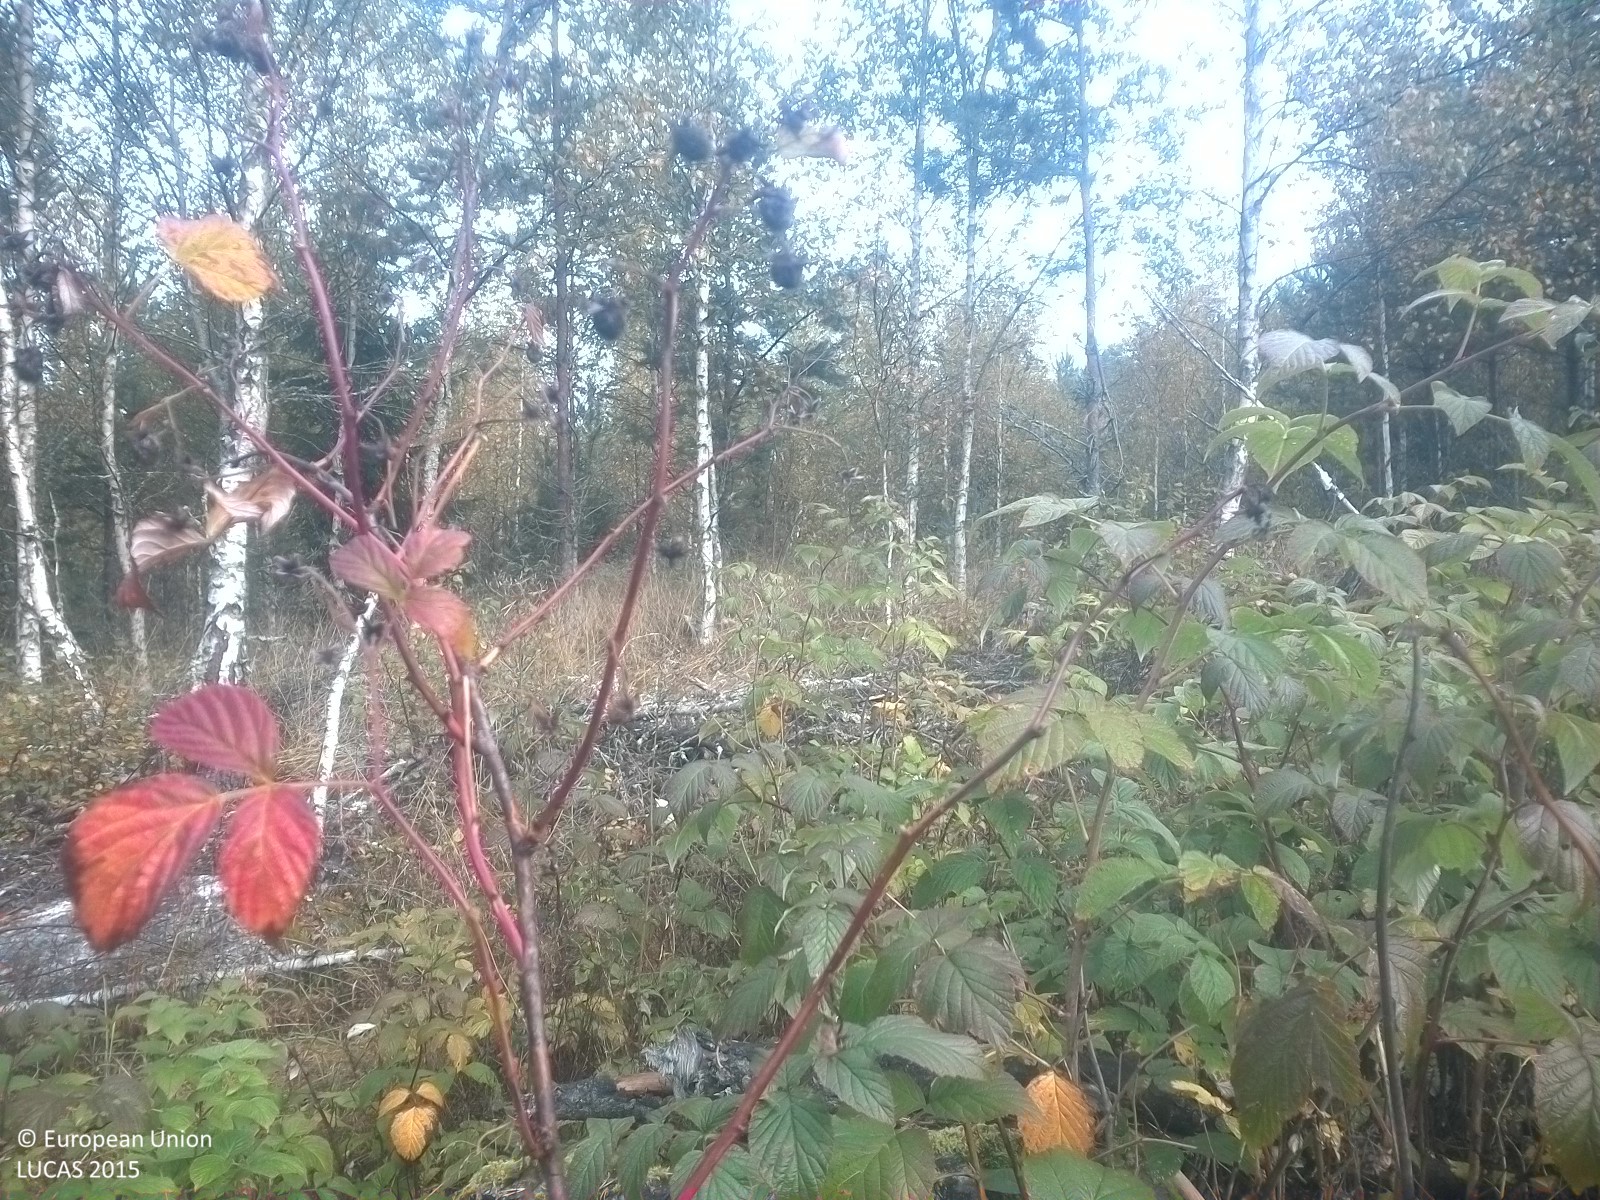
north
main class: Shrubland
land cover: Shrubland with sparse tree cover
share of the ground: > 75 %
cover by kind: shrubs 80 %, herbaceous plants 15 %, broadleaved forest trees 5 %
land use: Semi-natural and natural areas not in use
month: September
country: SE
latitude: 58.8565
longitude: 15.6967
